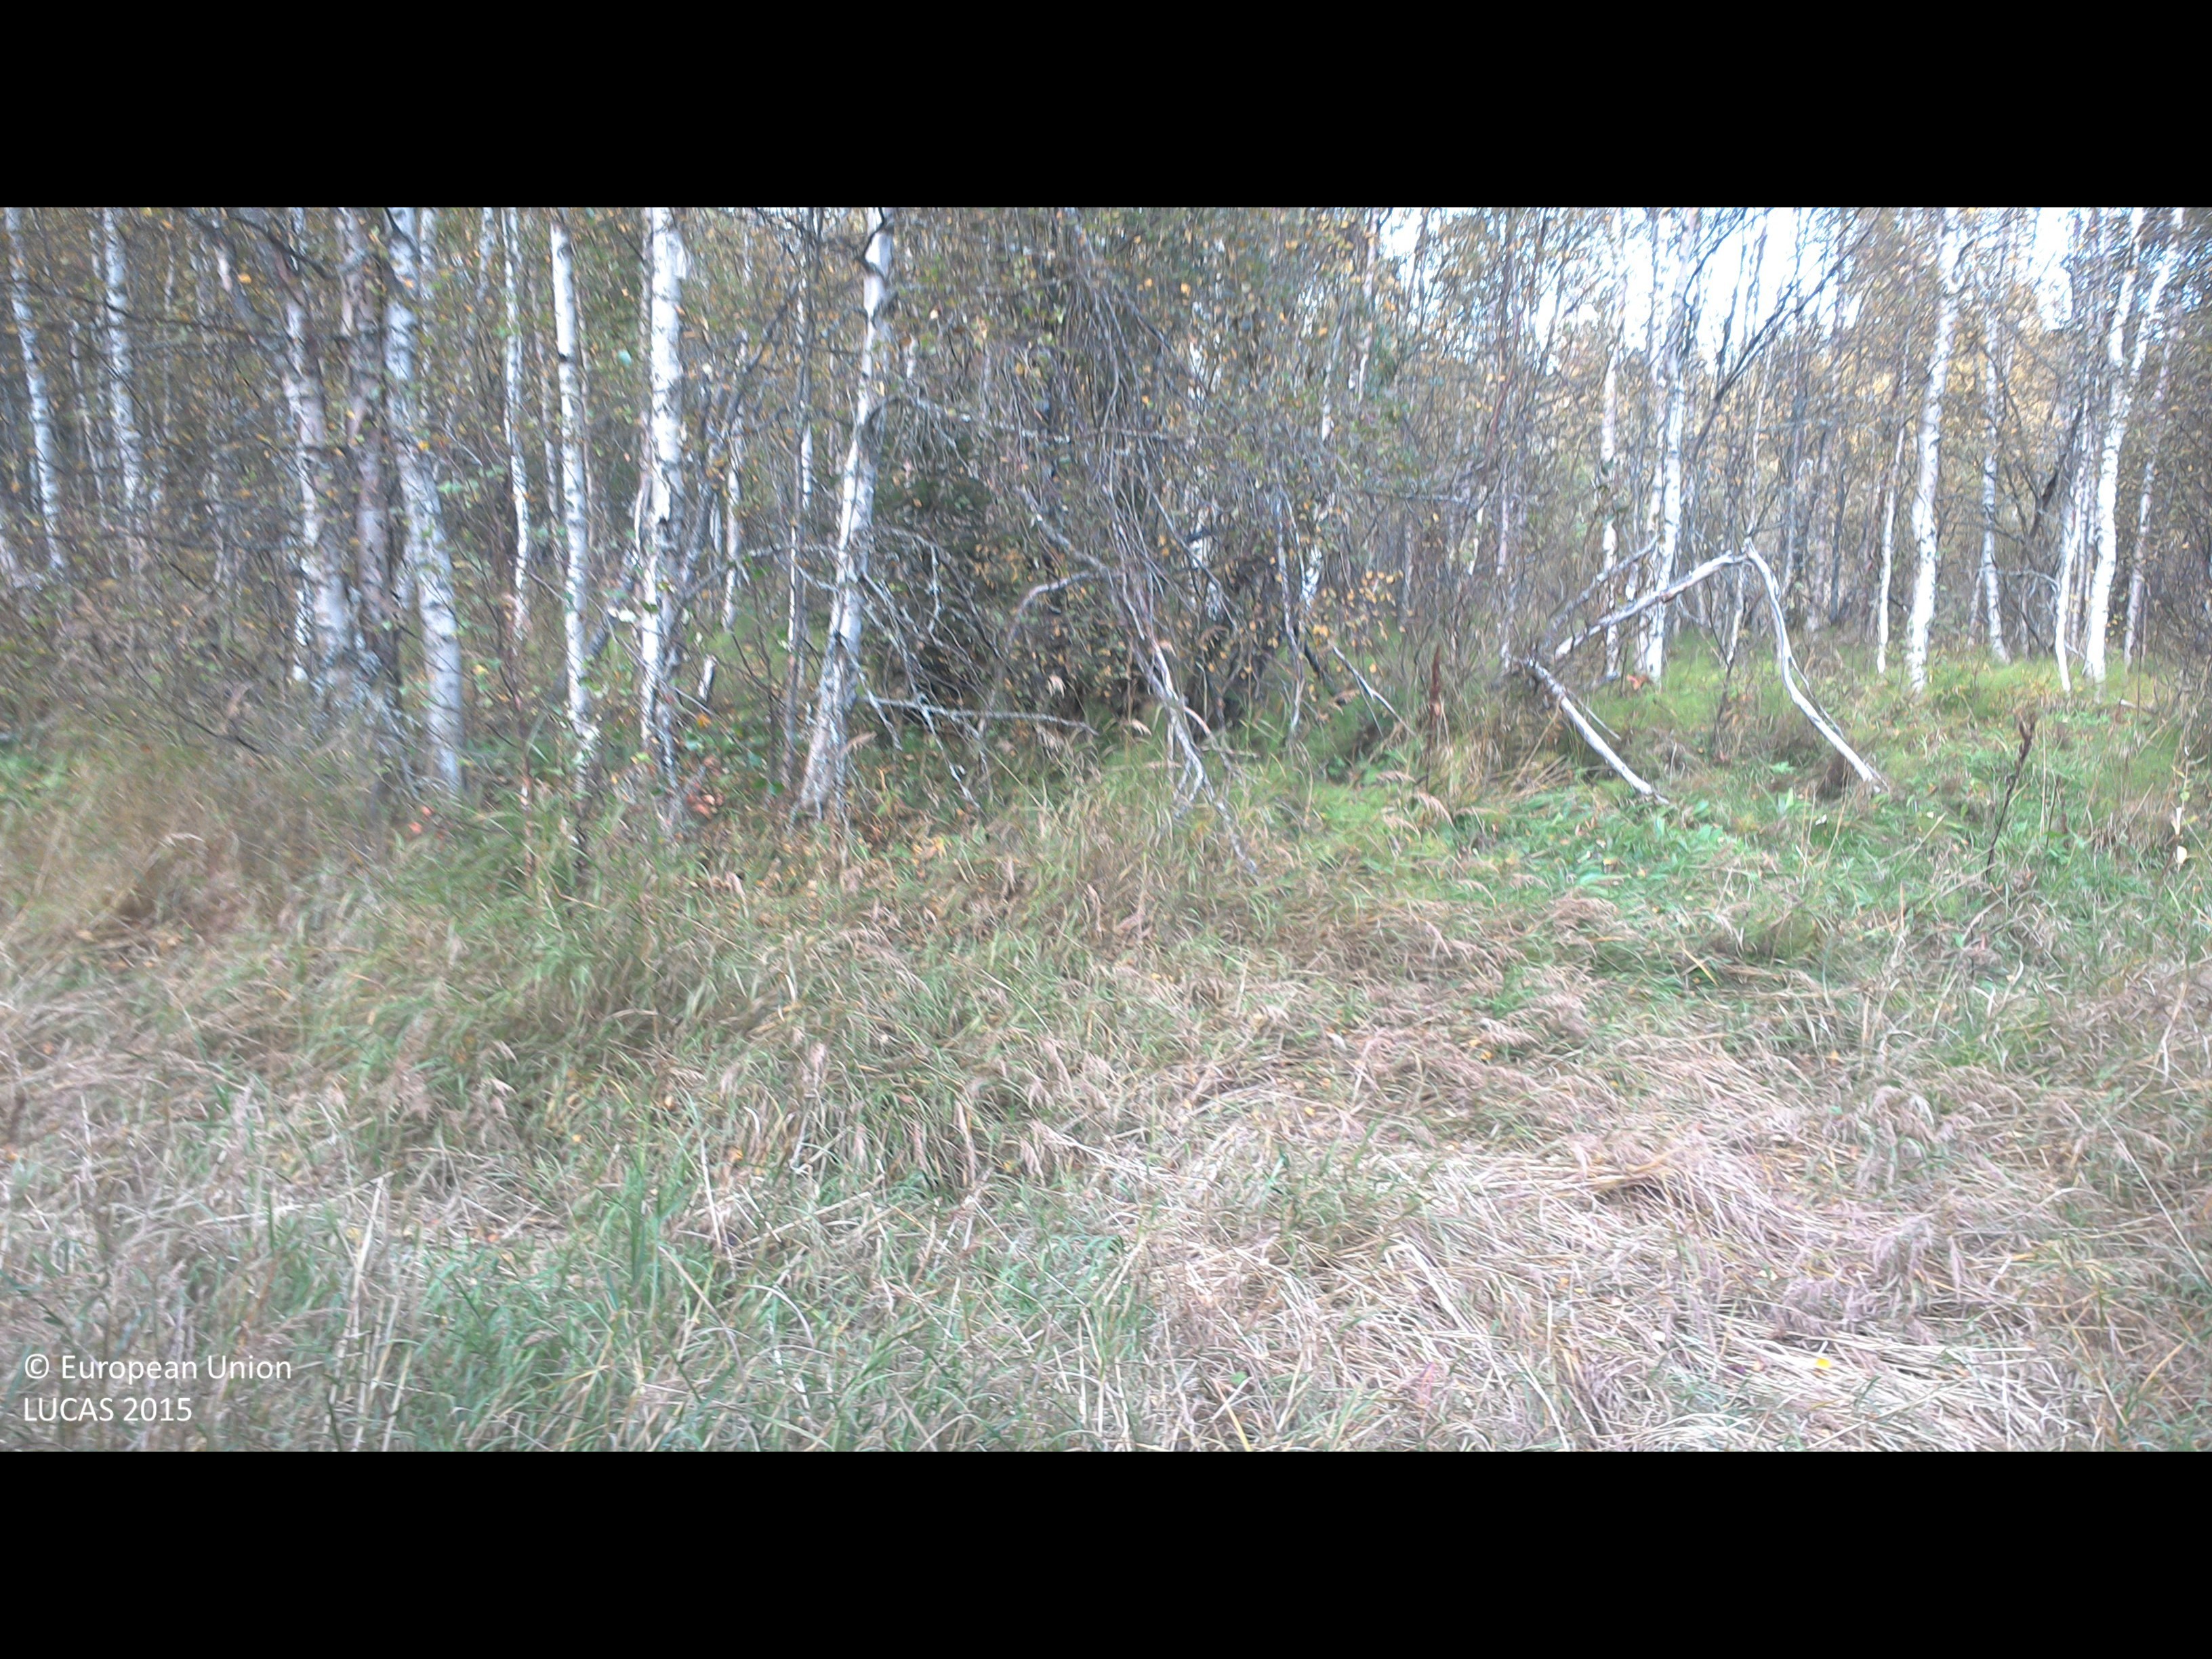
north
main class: Woodland
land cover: Broadleaved woodland
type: hemiboreal forest and nemoral coniferous forest and mixed broadleaved-coniferous forest
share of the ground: 25 - 50 %
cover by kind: broadleaved forest trees 50 %, shrubs 50 %
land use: Semi-natural and natural areas not in use
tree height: > 5 m
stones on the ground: < 10 %
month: September
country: SE
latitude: 63.9186
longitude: 19.9891
